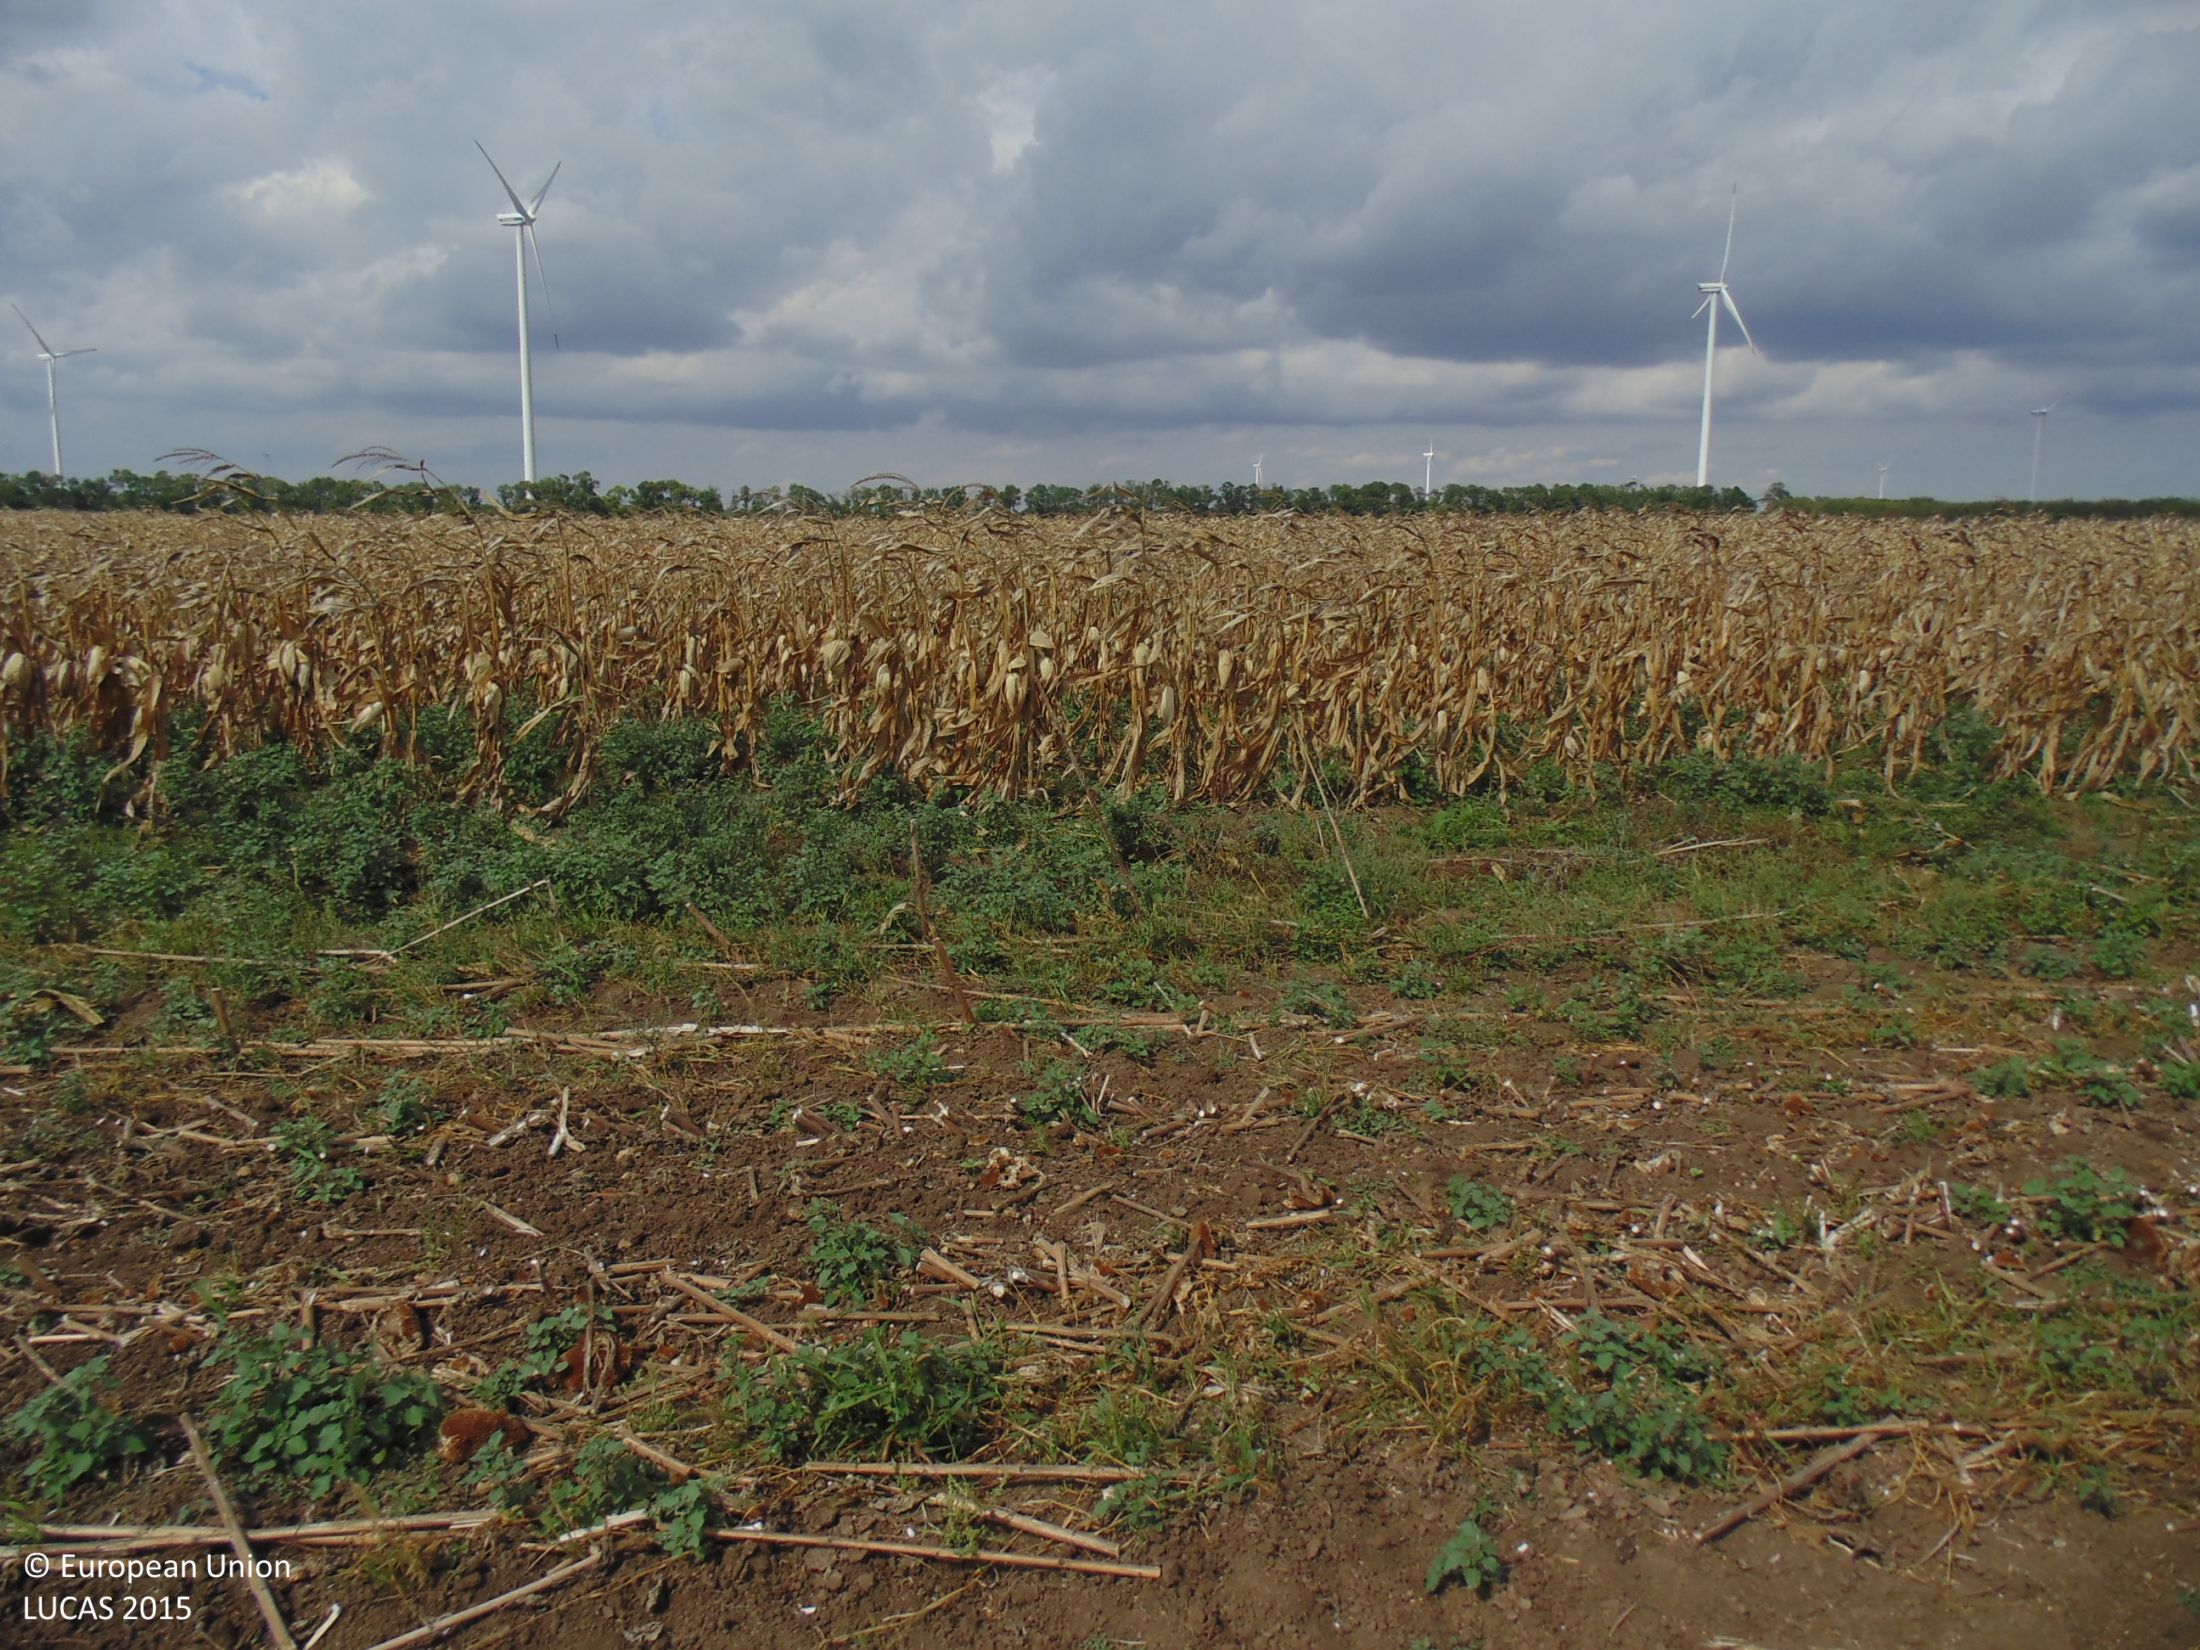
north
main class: Cropland
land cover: Sunflower
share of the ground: < 10 %
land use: Agriculture (excluding fallow land and kitchen gardens)
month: September
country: BG
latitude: 43.4346
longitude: 28.4552
